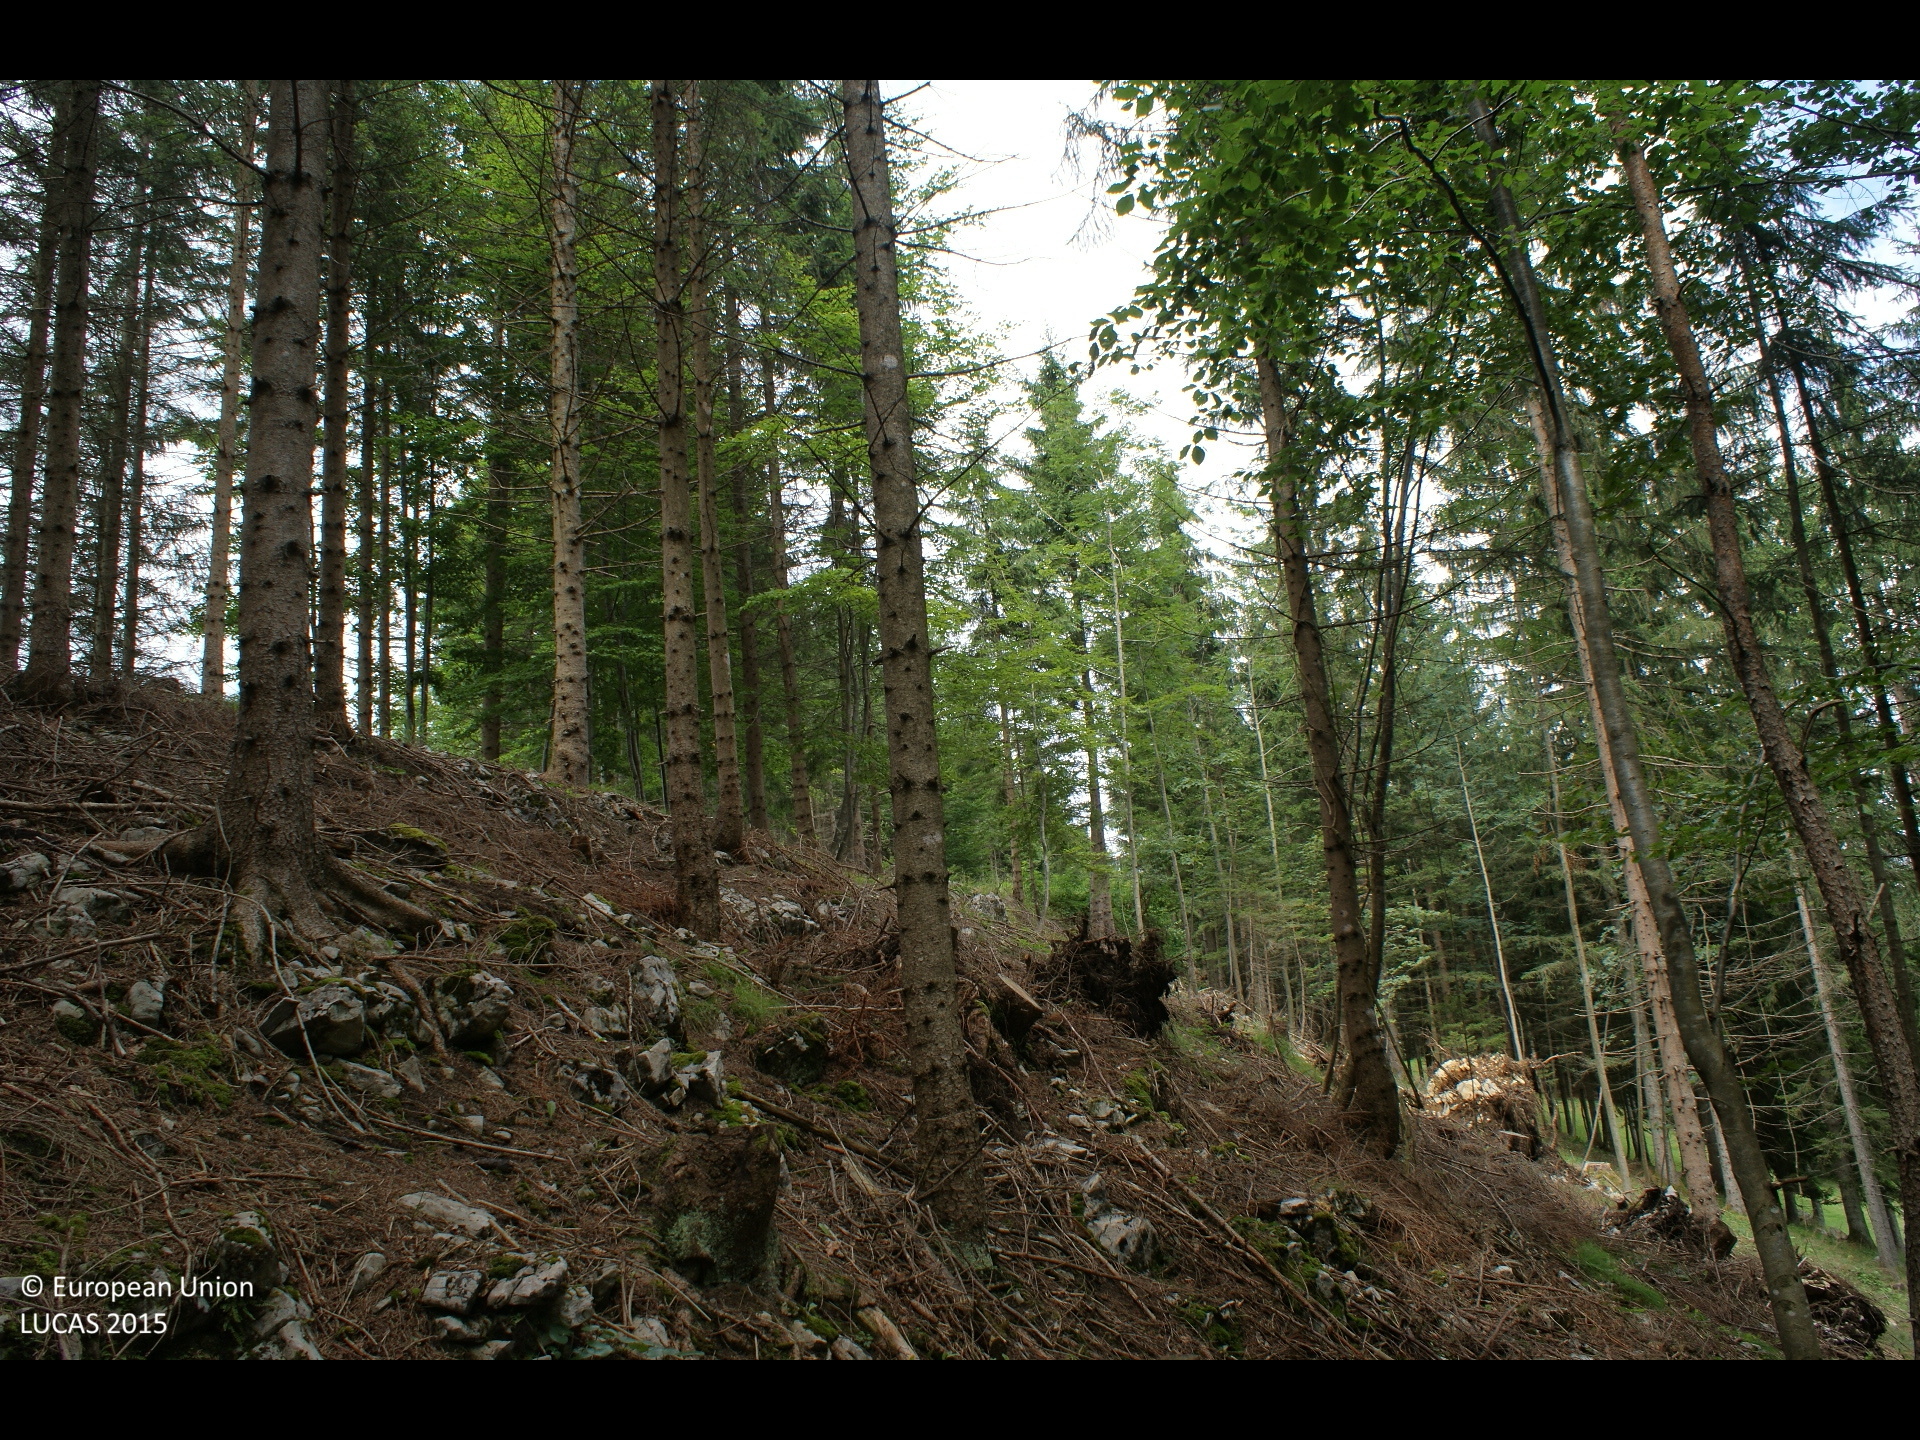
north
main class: Woodland
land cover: Spruce dominated coniferous woodland
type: alpine coniferous forest
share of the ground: > 75 %
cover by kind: coniferous forest trees 80 %, unconsolidated bare surface 10 %, broadleaved forest trees 5 %, herbaceous plants 5 %
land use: Forestry
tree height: > 5 m
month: July
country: AT
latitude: 47.7878
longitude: 14.9525
